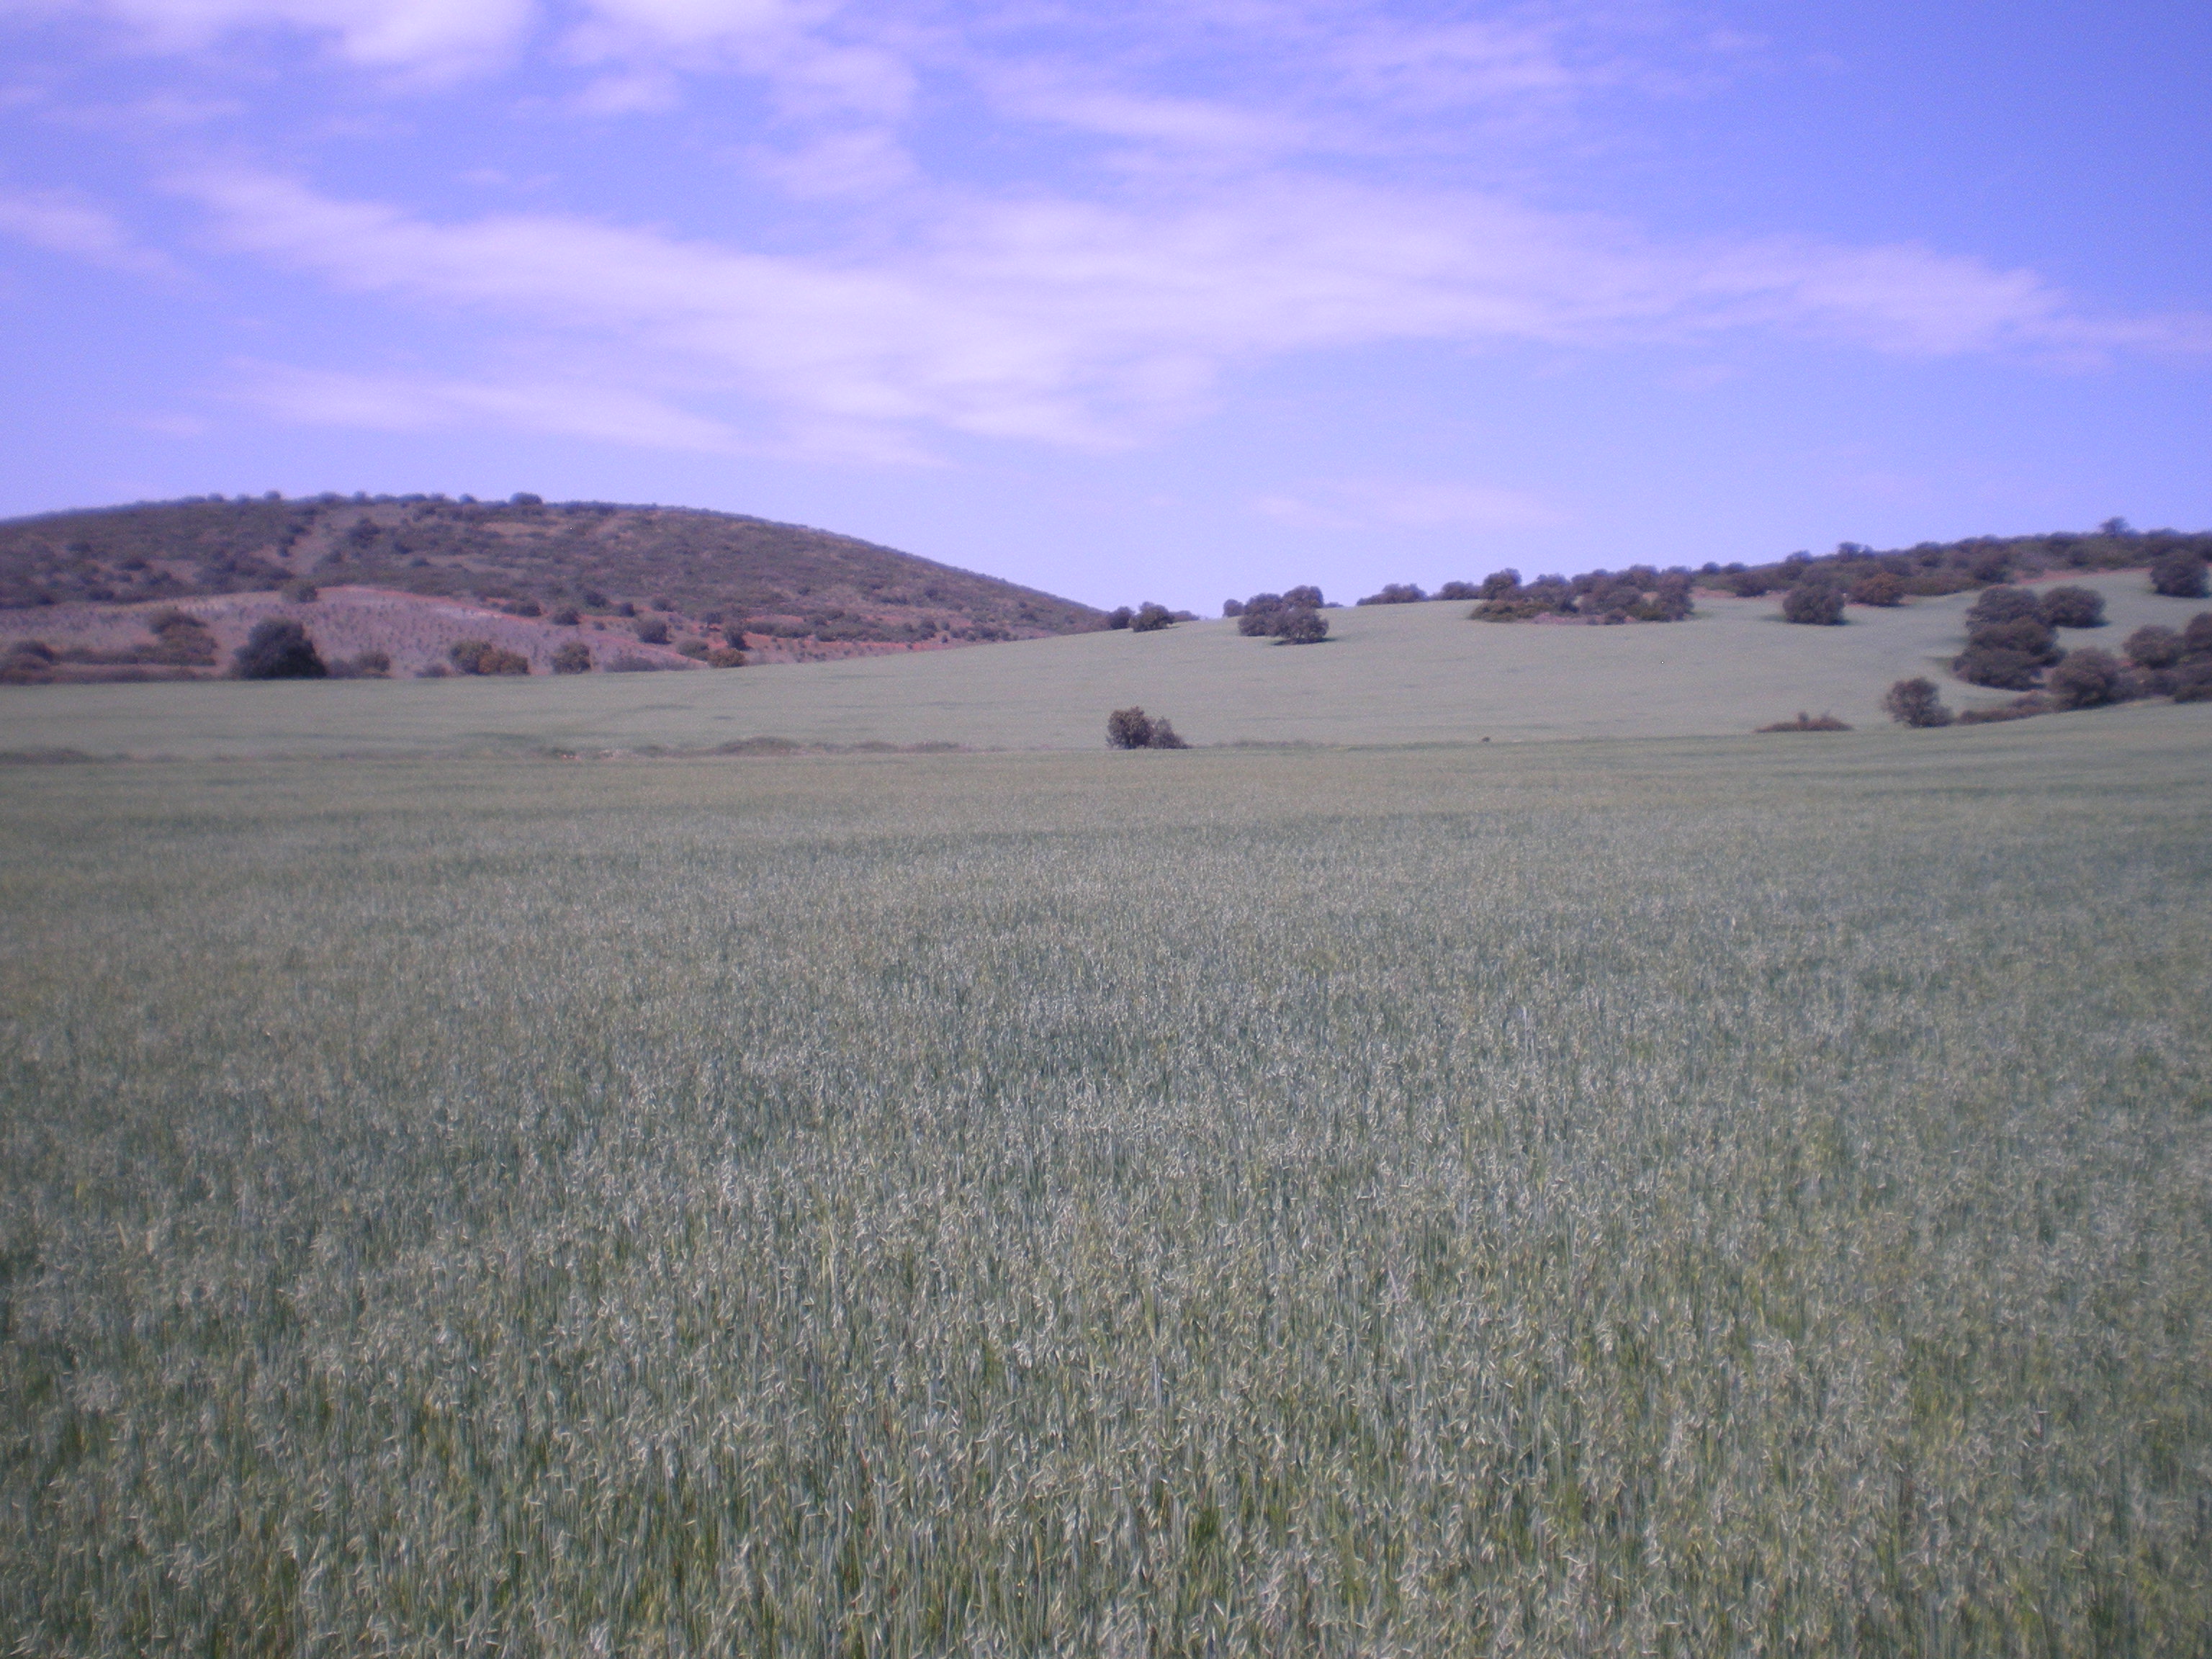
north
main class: Cropland
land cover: Oats
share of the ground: > 75 %
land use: Agriculture (excluding fallow land and kitchen gardens)
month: April
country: ES
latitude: 38.6288
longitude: -3.5307
